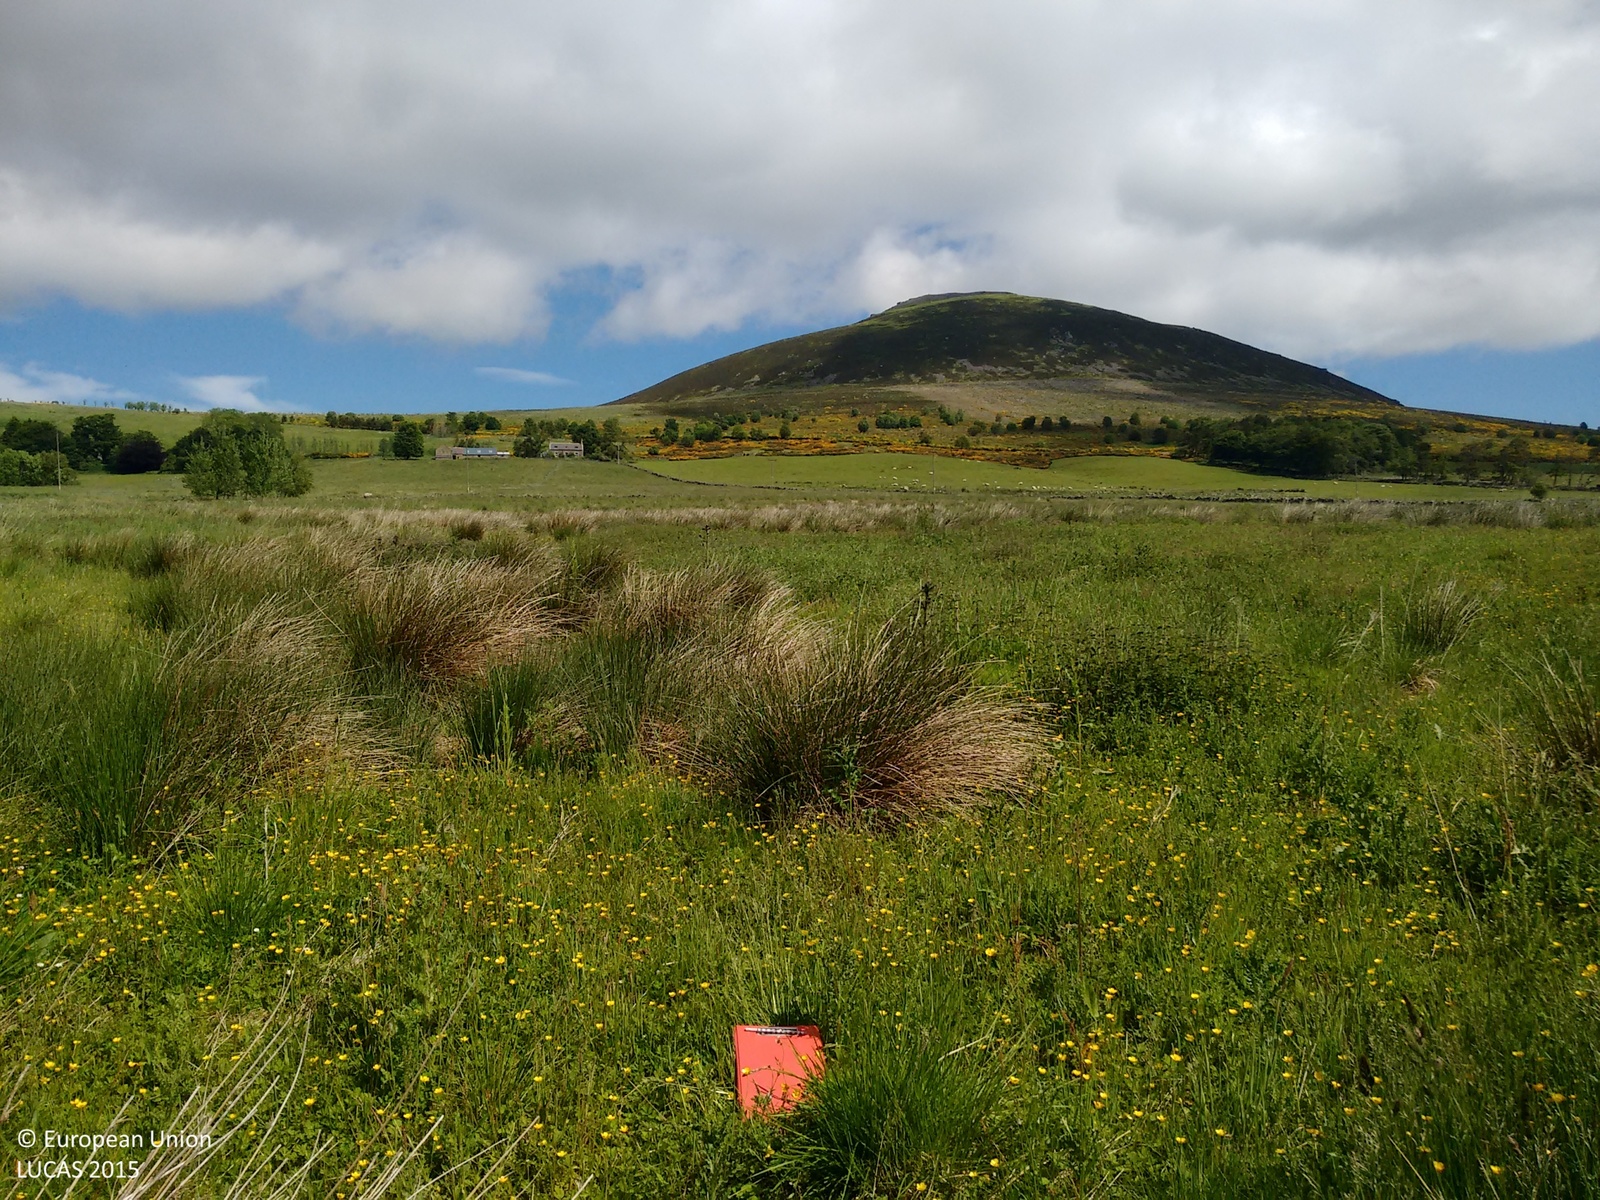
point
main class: Grassland
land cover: Grassland without tree/shrub cover
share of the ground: > 75 %
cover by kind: herbaceous plants 100 %
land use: Agriculture (excluding fallow land and kitchen gardens)
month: June
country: GB
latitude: 57.3419
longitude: -2.8702
